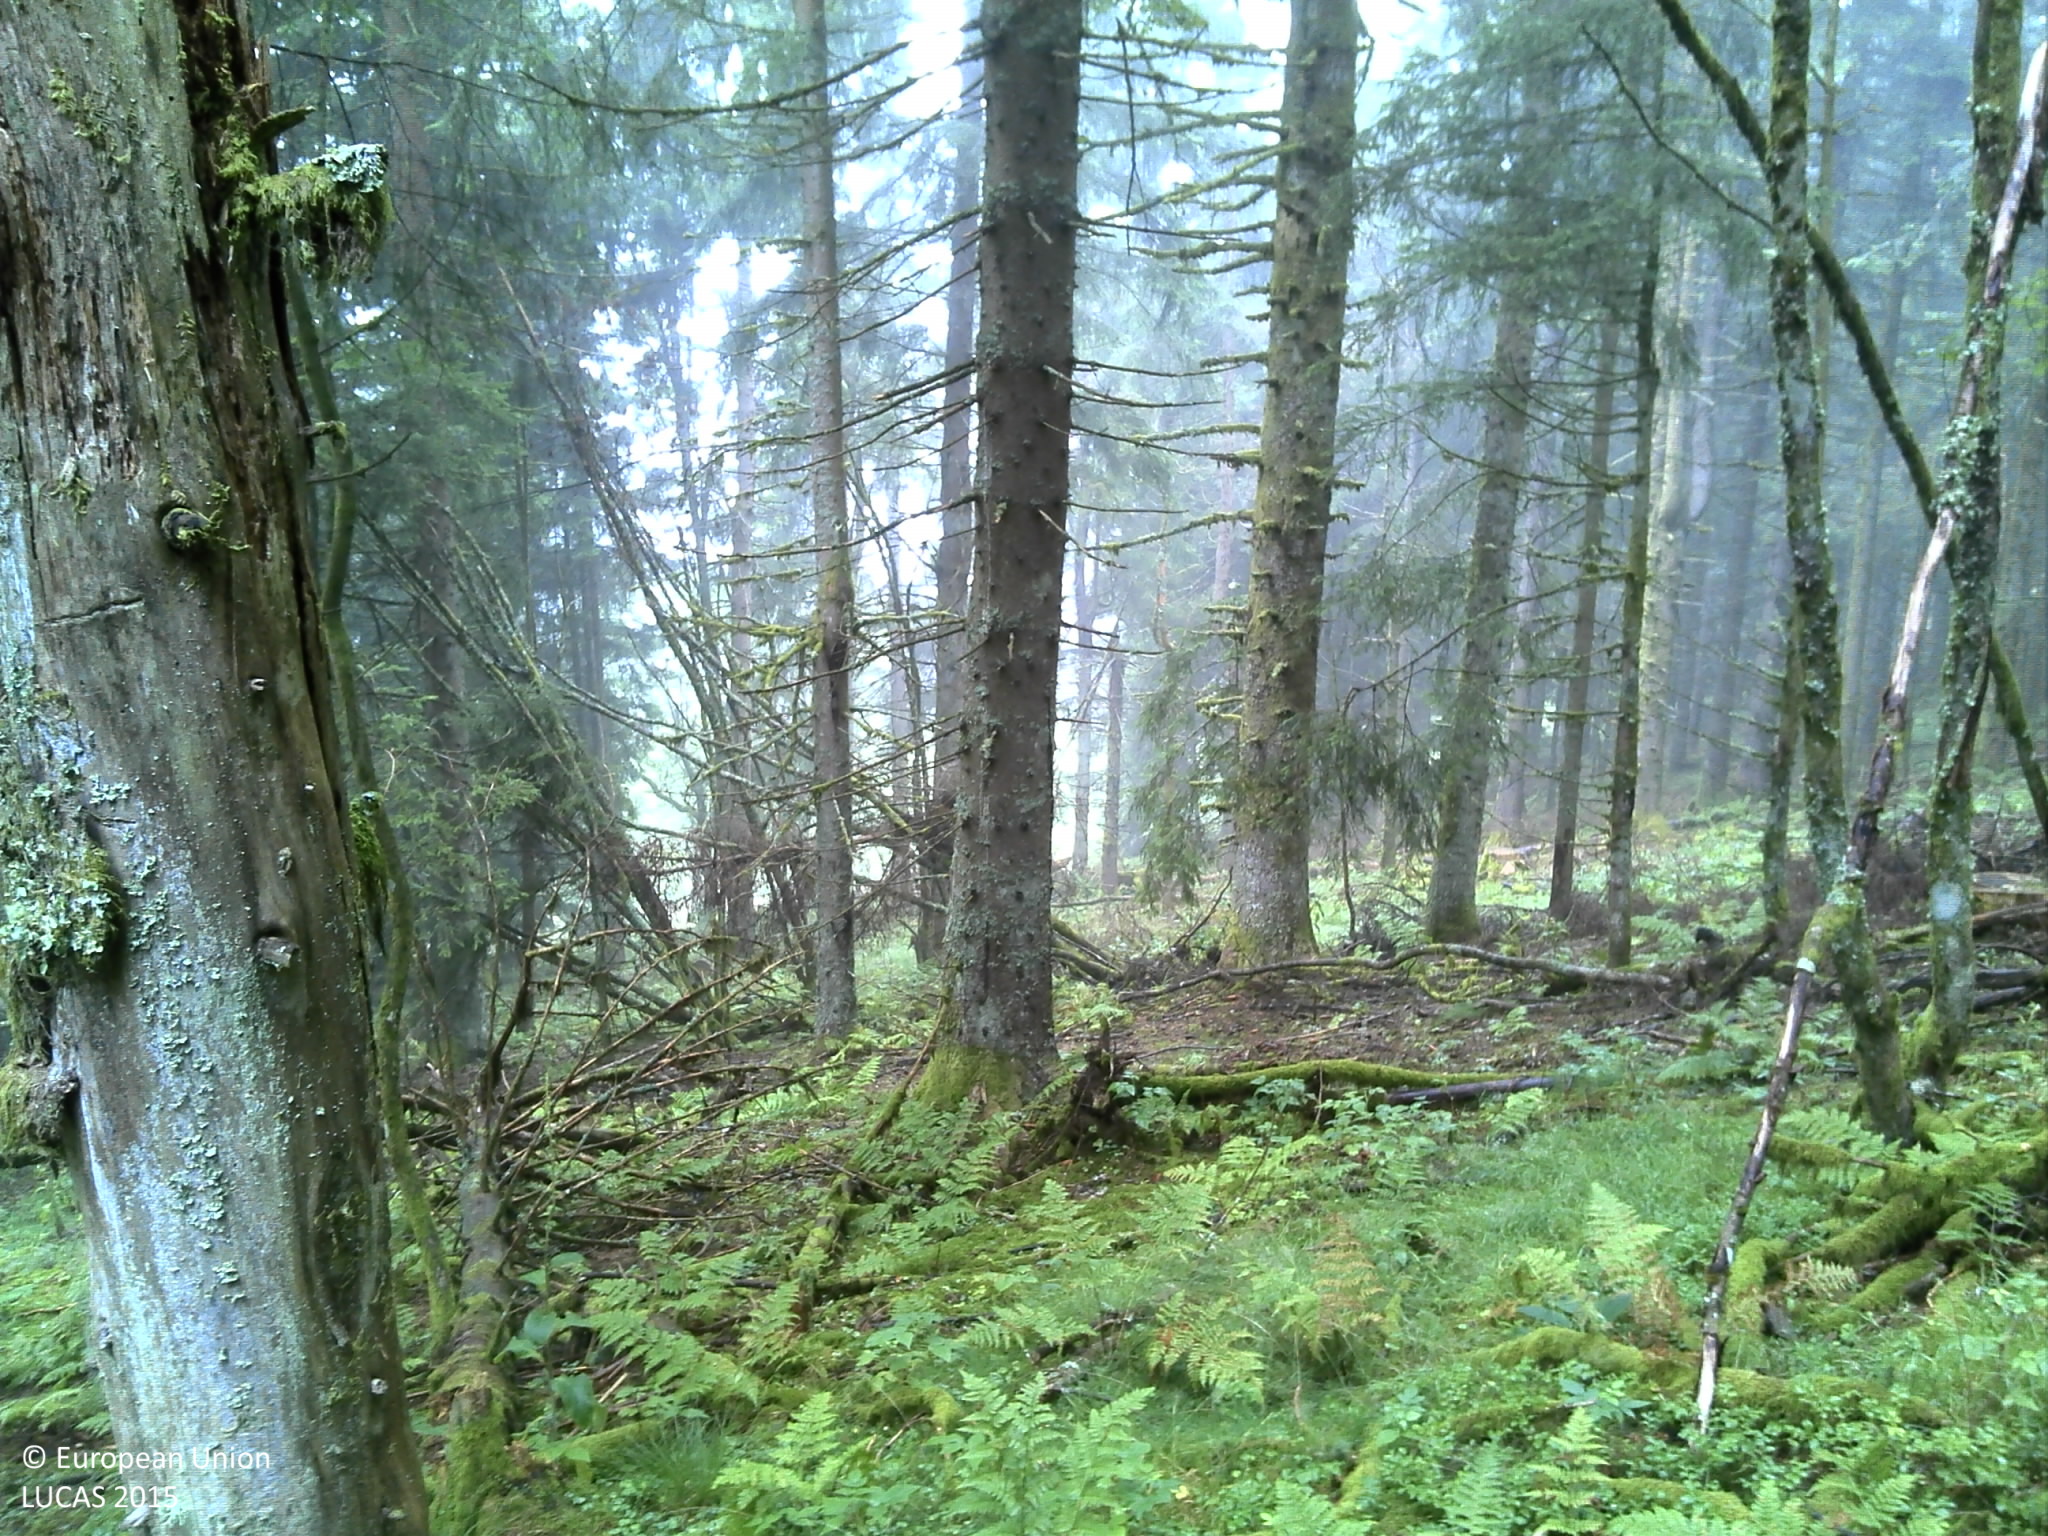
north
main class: Woodland
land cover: Spruce dominated coniferous woodland
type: alpine coniferous forest
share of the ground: > 75 %
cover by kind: coniferous forest trees 90 %, herbaceous plants 10 %
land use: Forestry
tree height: > 5 m
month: August
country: FR
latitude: 47.9806
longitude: 6.8527
